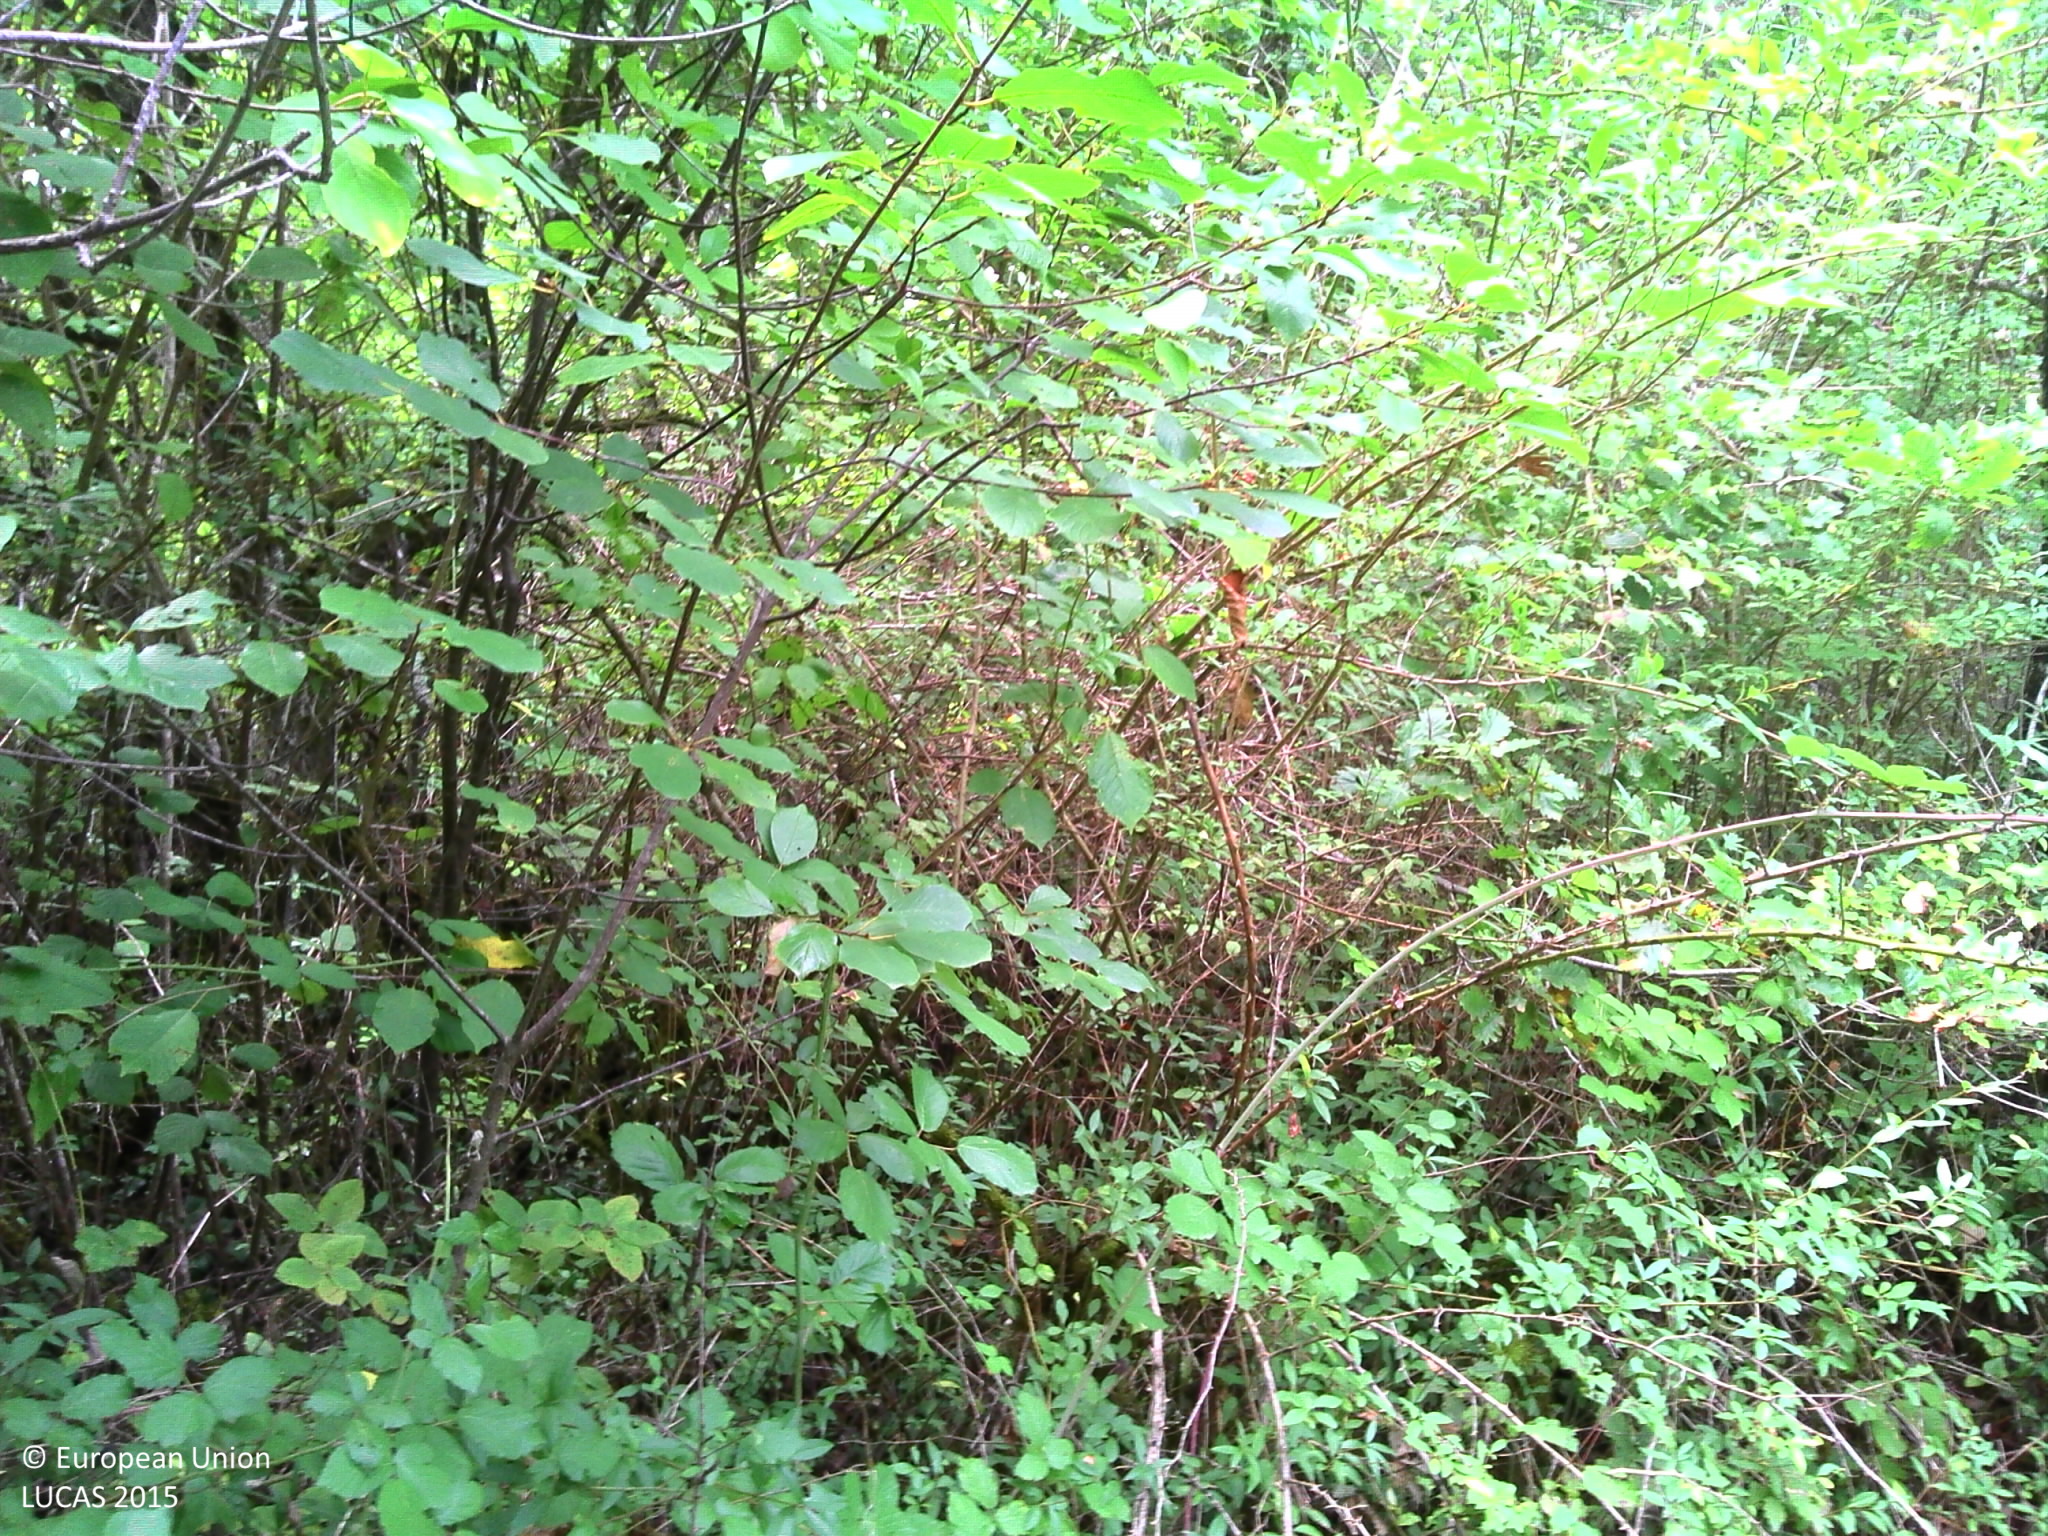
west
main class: Woodland
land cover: Broadleaved woodland
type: mesophytic deciduous forest
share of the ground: > 75 %
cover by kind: broadleaved forest trees 70 %, shrubs 20 %, herbaceous plants 10 %
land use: Forestry
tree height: > 5 m
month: August
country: FR
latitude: 45.2872
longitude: 0.4381
